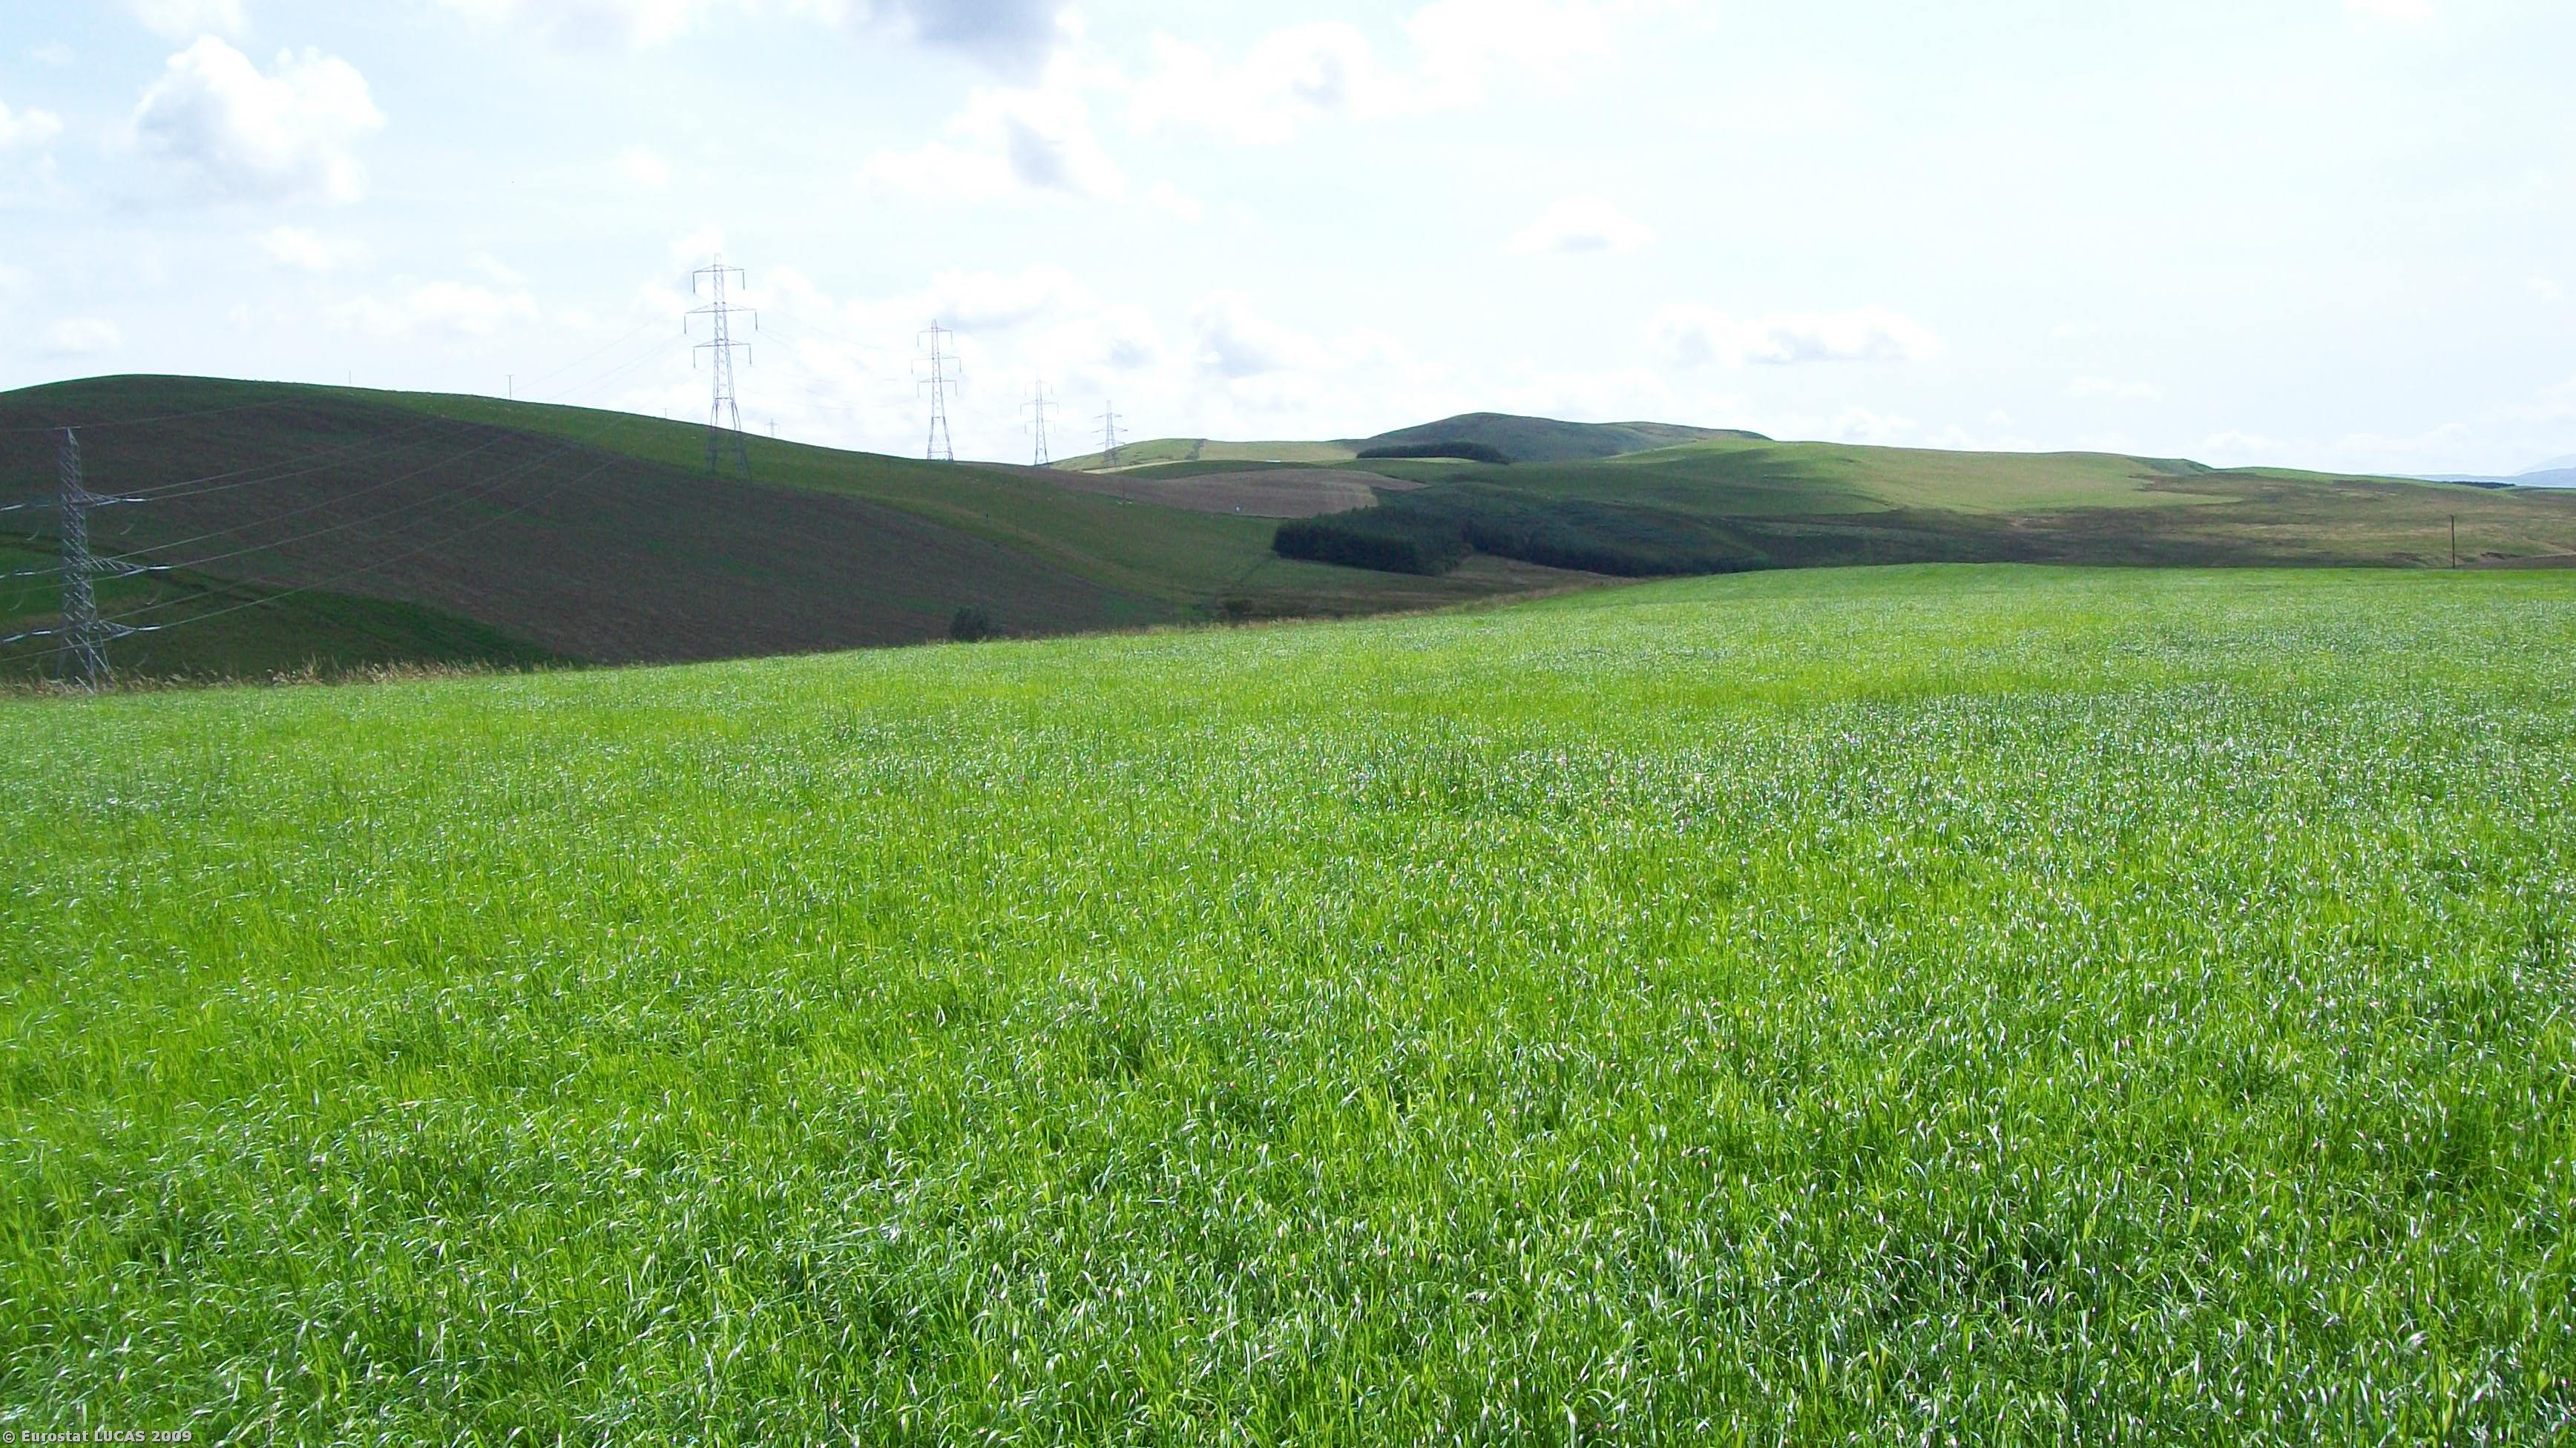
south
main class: Grassland
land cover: Grassland without tree/shrub cover
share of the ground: > 75 %
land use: Agriculture (excluding fallow land and kitchen gardens)
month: August
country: GB
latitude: 55.2291
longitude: -3.3630
